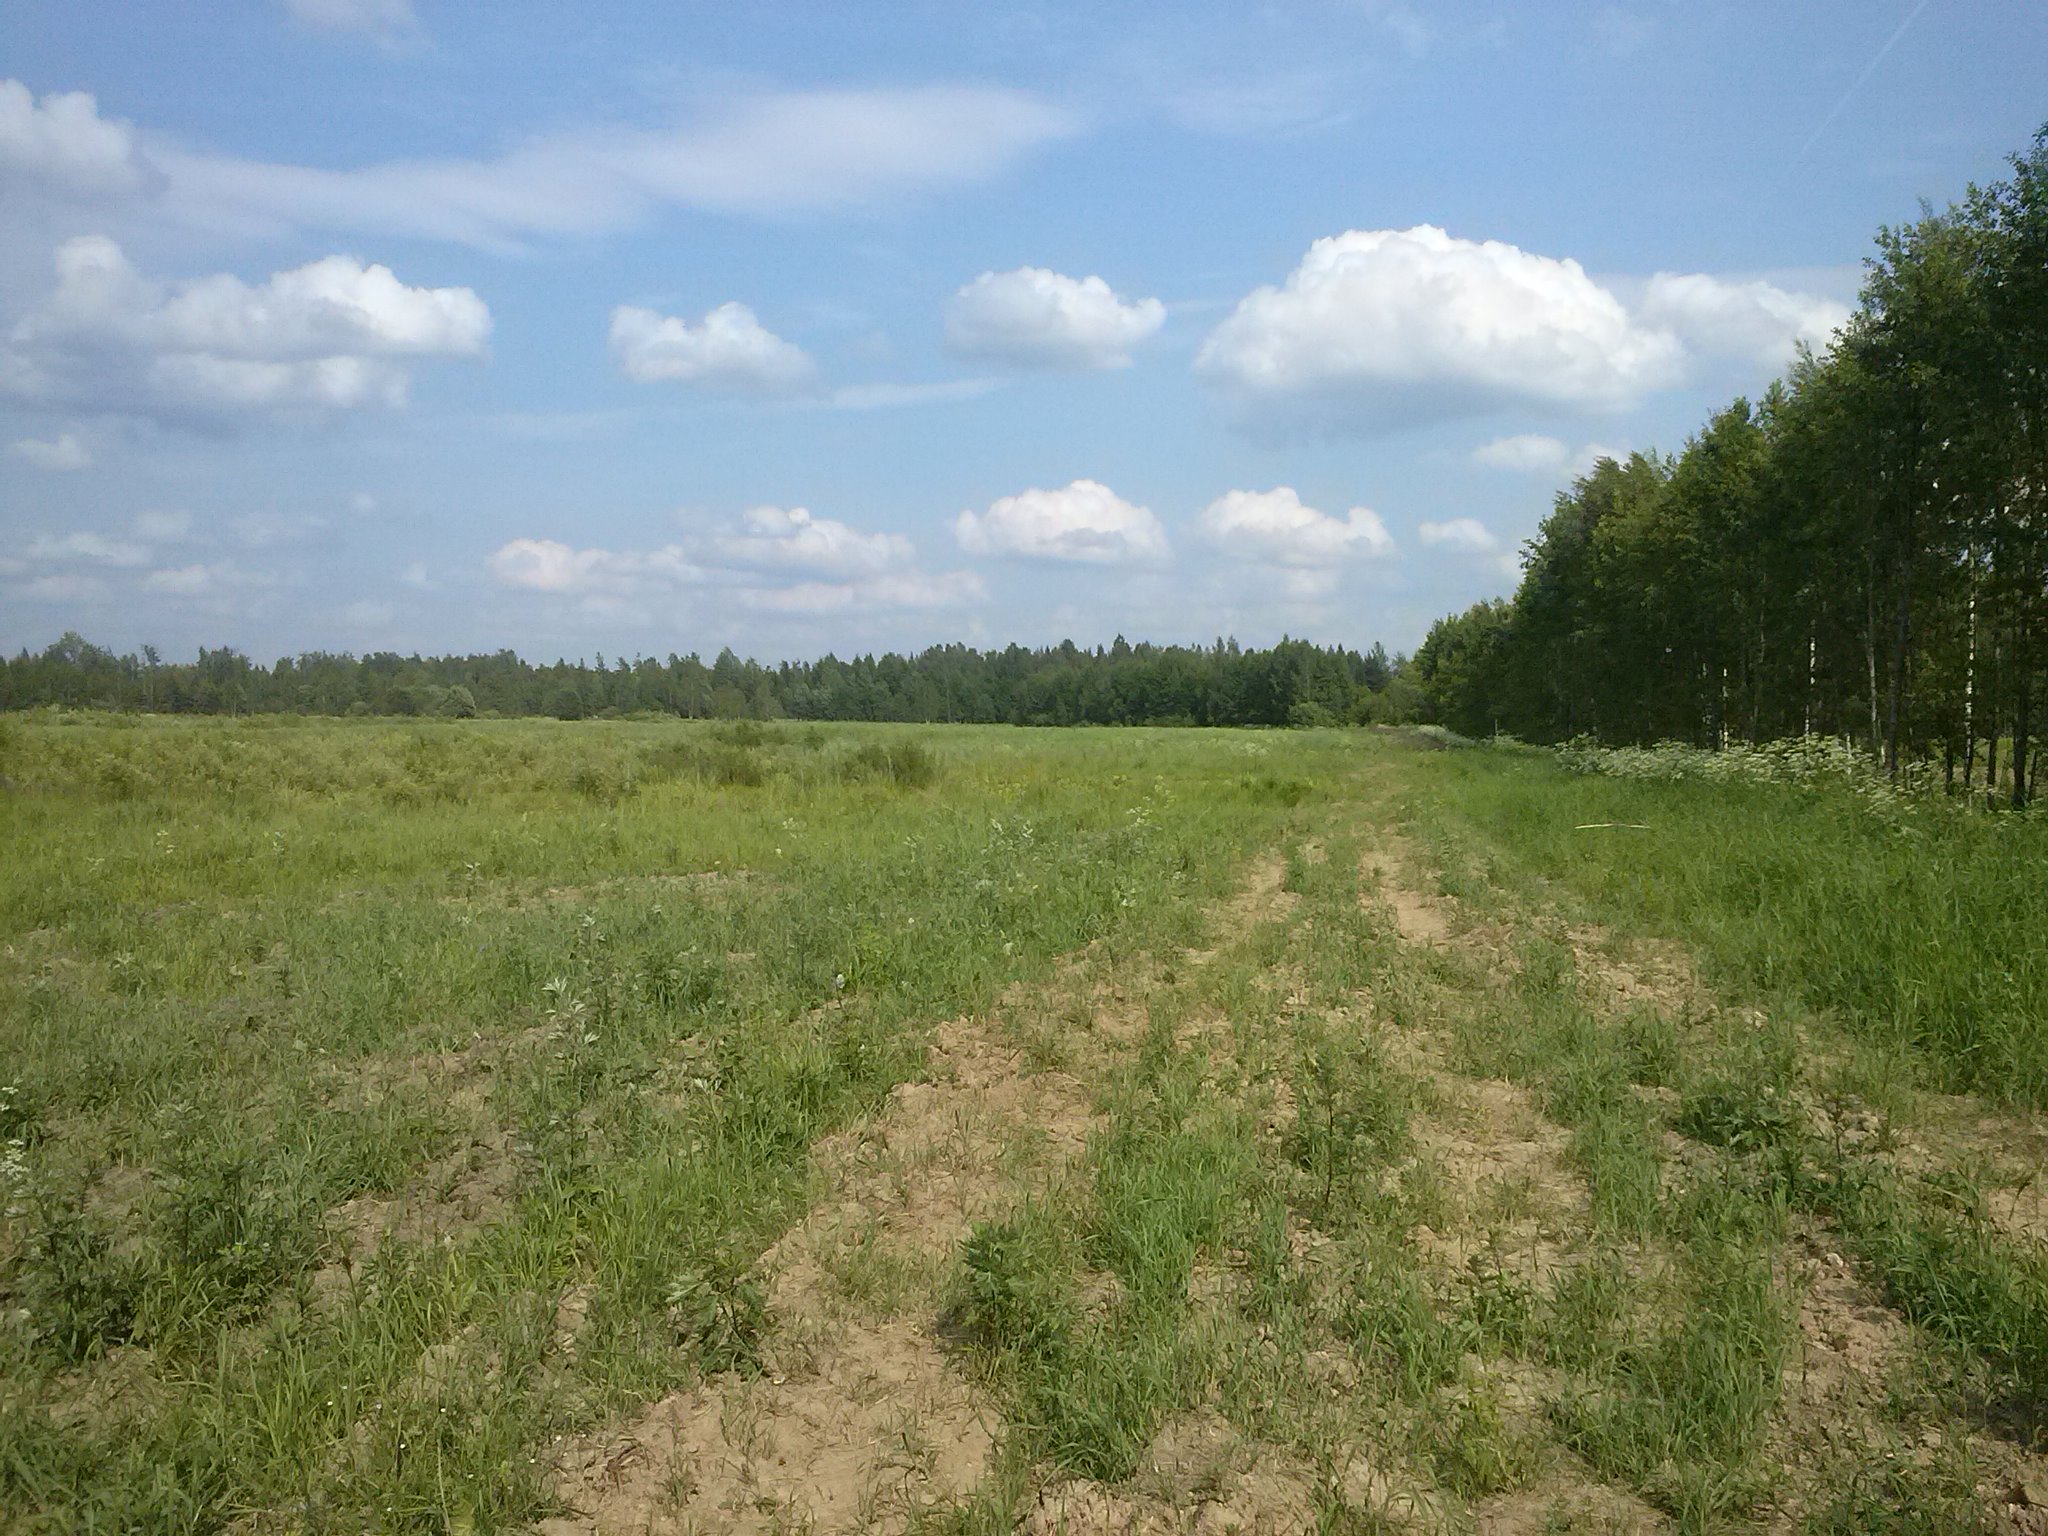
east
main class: Grassland
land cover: Grassland without tree/shrub cover
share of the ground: 50 - 75 %
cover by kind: herbaceous plants 70 %, unconsolidated bare surface 30 %
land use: Agriculture (excluding fallow land and kitchen gardens)
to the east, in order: Grassland without tree/shrub cover
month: June
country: LV
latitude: 56.8606
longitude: 27.1751
